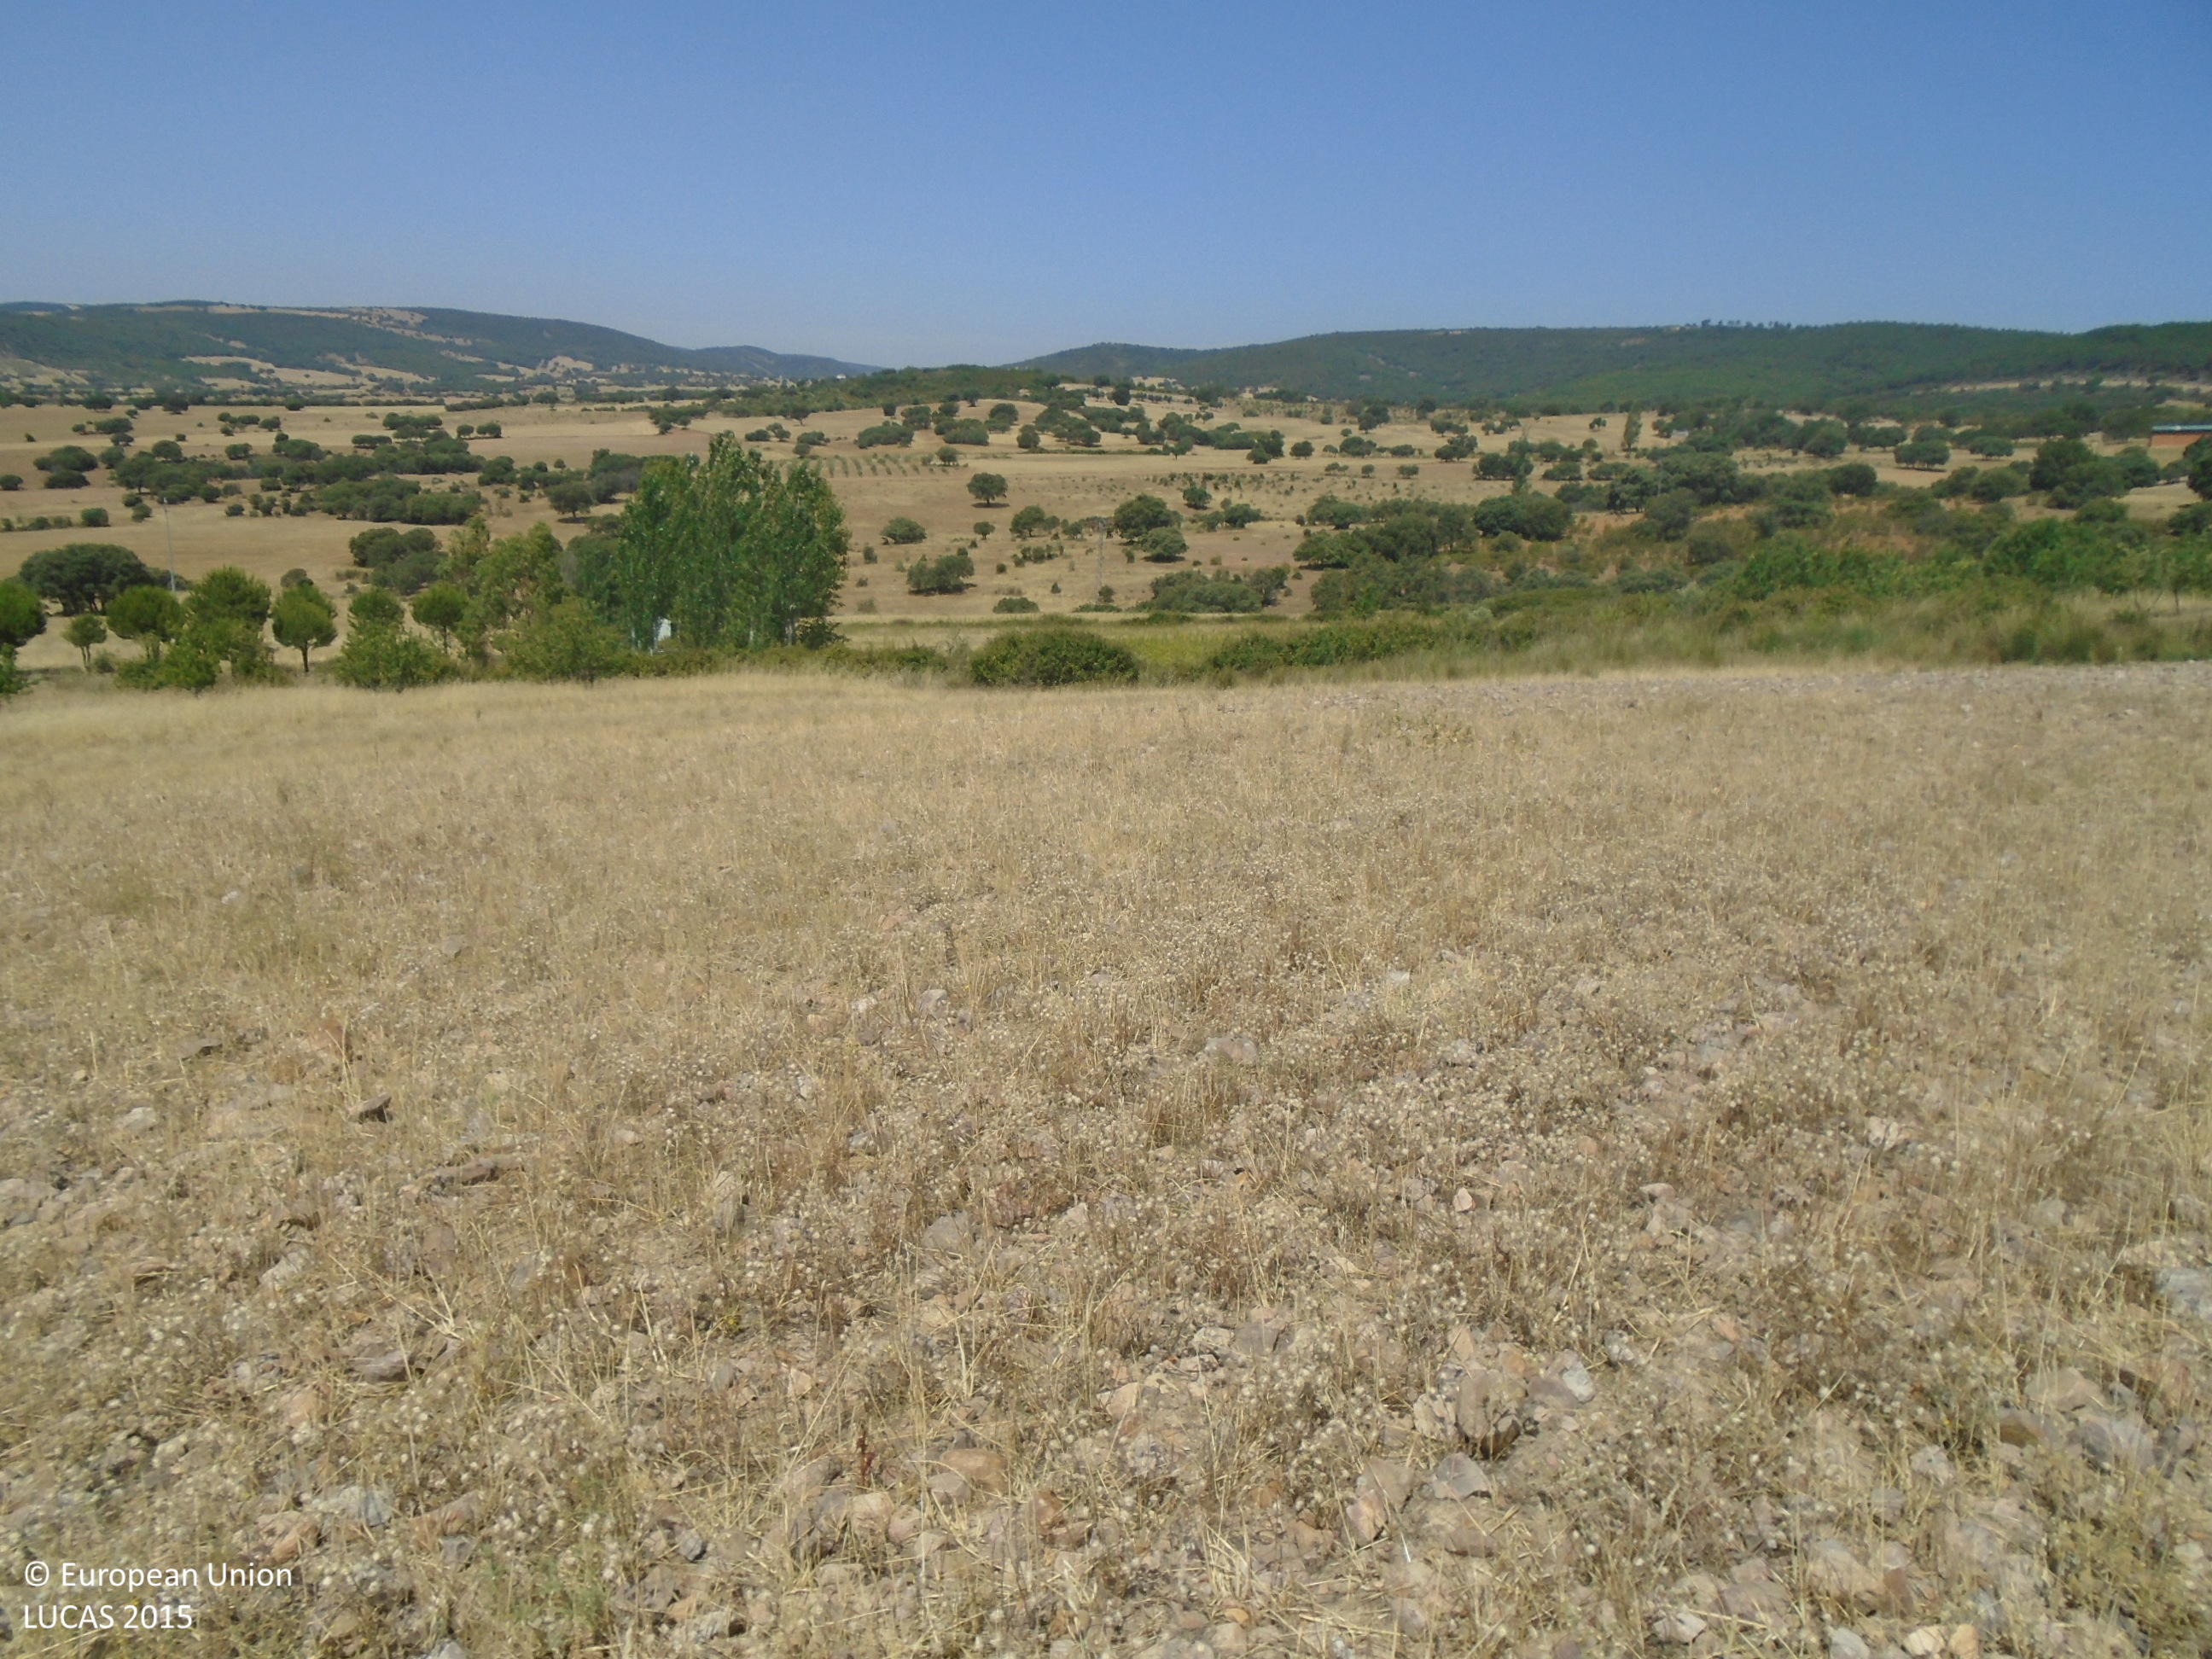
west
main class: Grassland
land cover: Spontaneously vegetated surfaces
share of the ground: > 75 %
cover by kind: herbaceous plants 80 %, consolidated bare surface 20 %
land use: Agriculture (excluding fallow land and kitchen gardens)
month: July
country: ES
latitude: 39.3383
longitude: -4.0778
